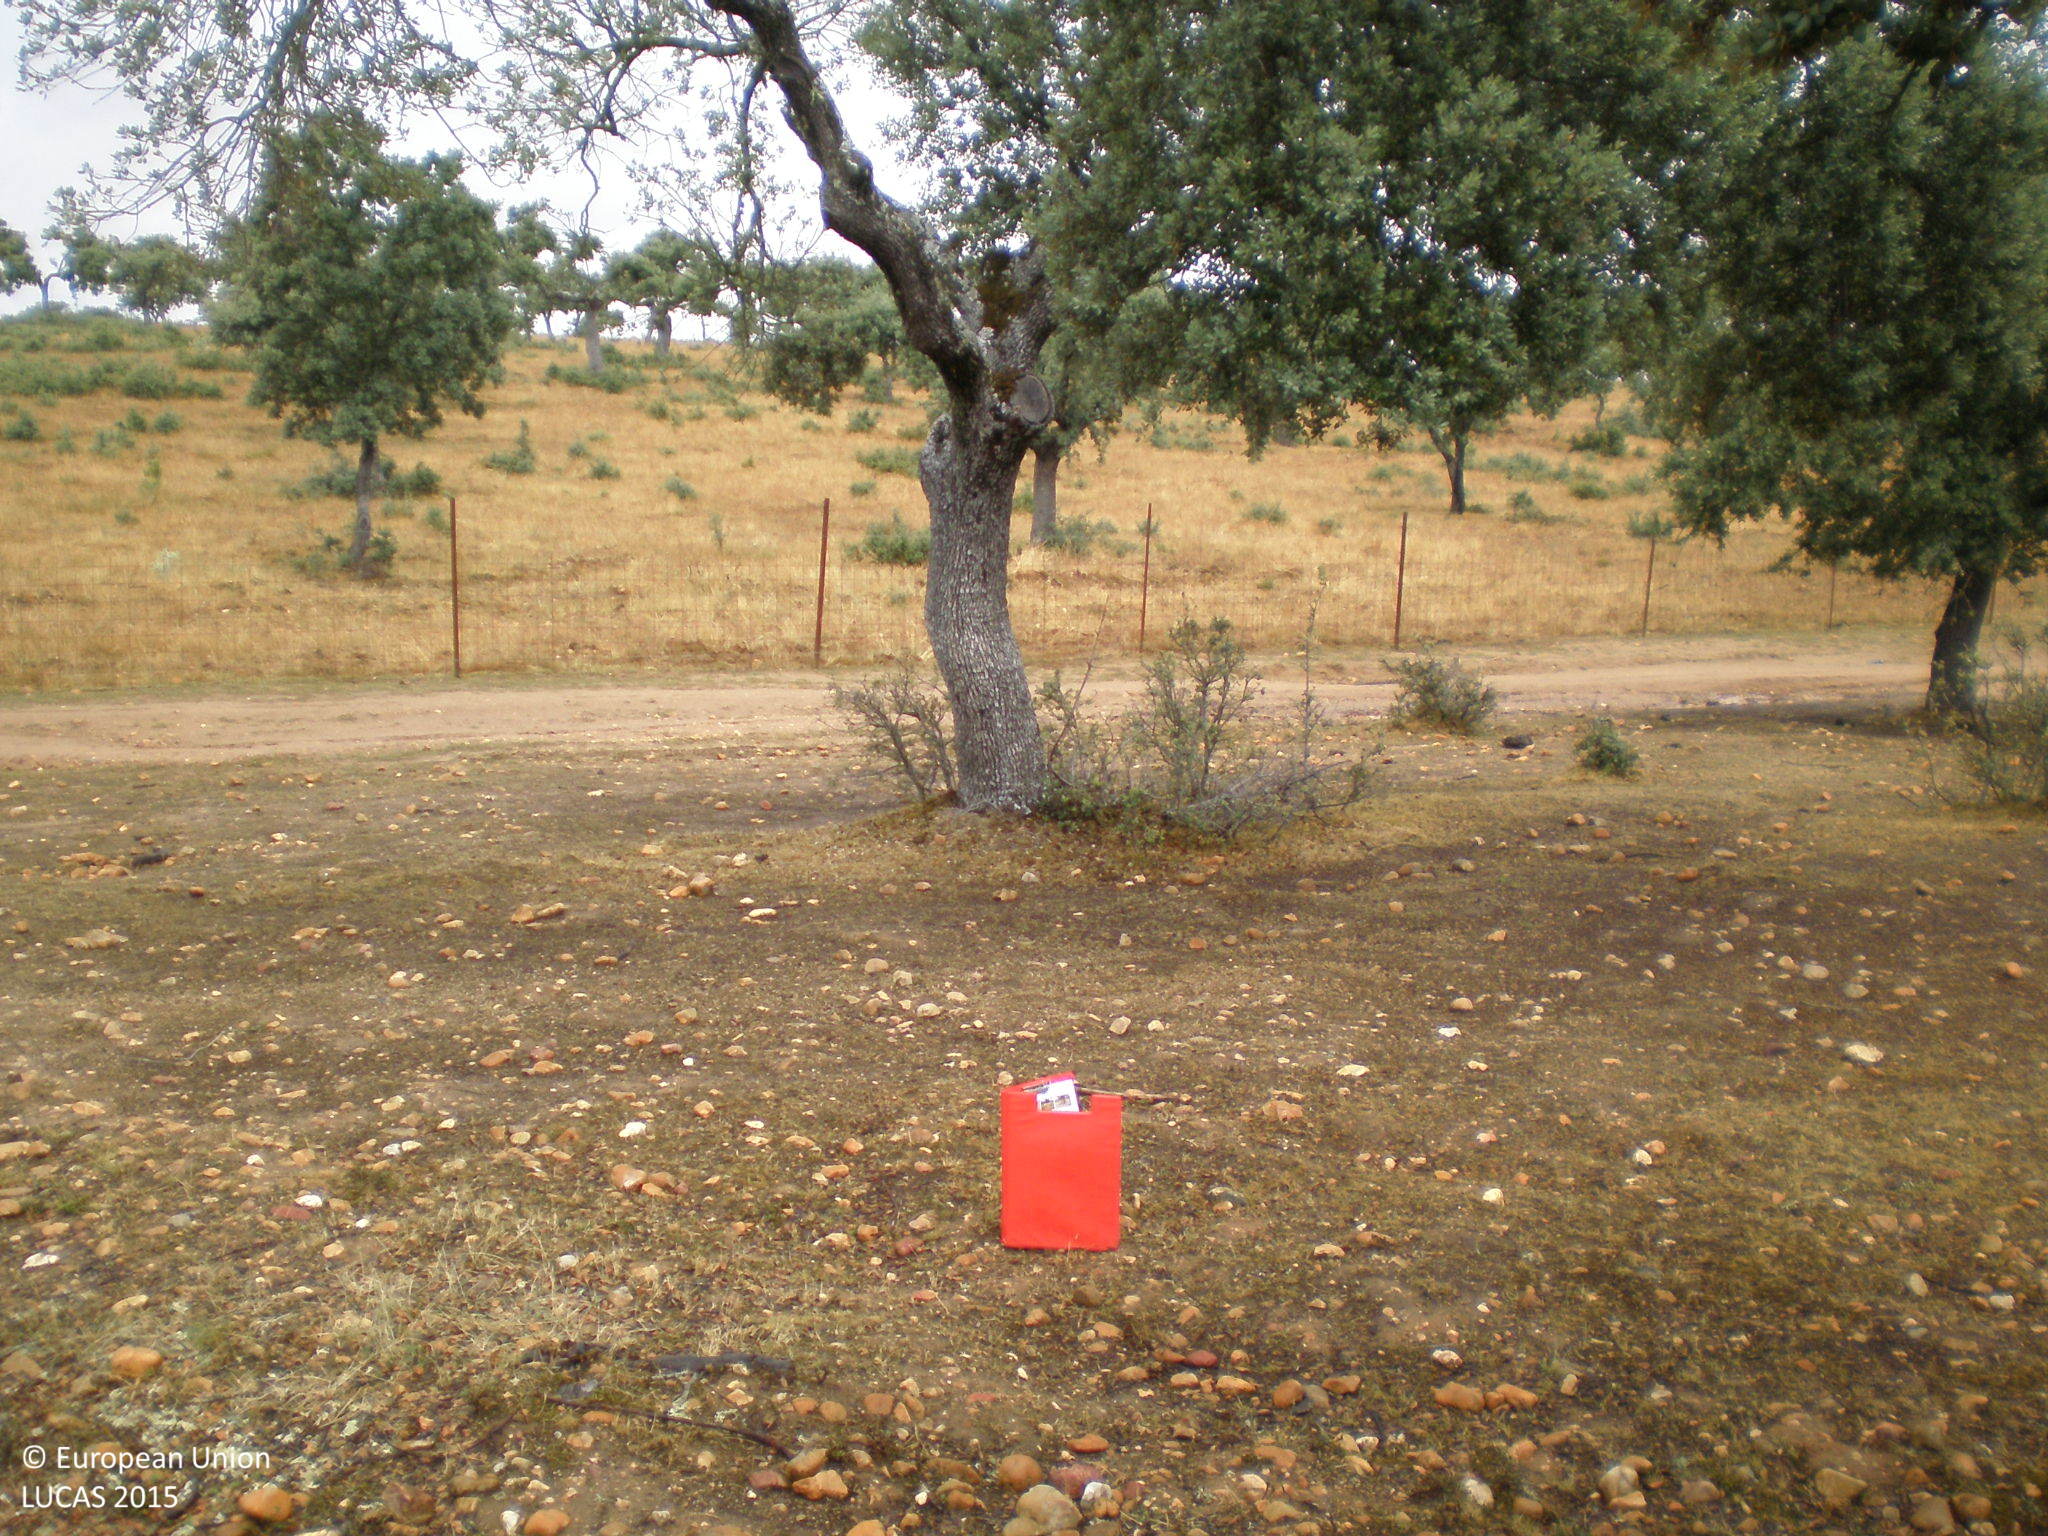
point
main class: Woodland
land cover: Broadleaved woodland
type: broadleaved evergreen forest
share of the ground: 25 - 50 %
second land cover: Grassland without tree/shrub cover
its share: 50 - 75 %
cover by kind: herbaceous plants 70 %, broadleaved forest trees 30 %
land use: Forestry
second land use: Agriculture (excluding fallow land and kitchen gardens)
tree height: > 5 m
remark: Clear cut
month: June
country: ES
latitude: 41.0066
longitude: -5.7623
